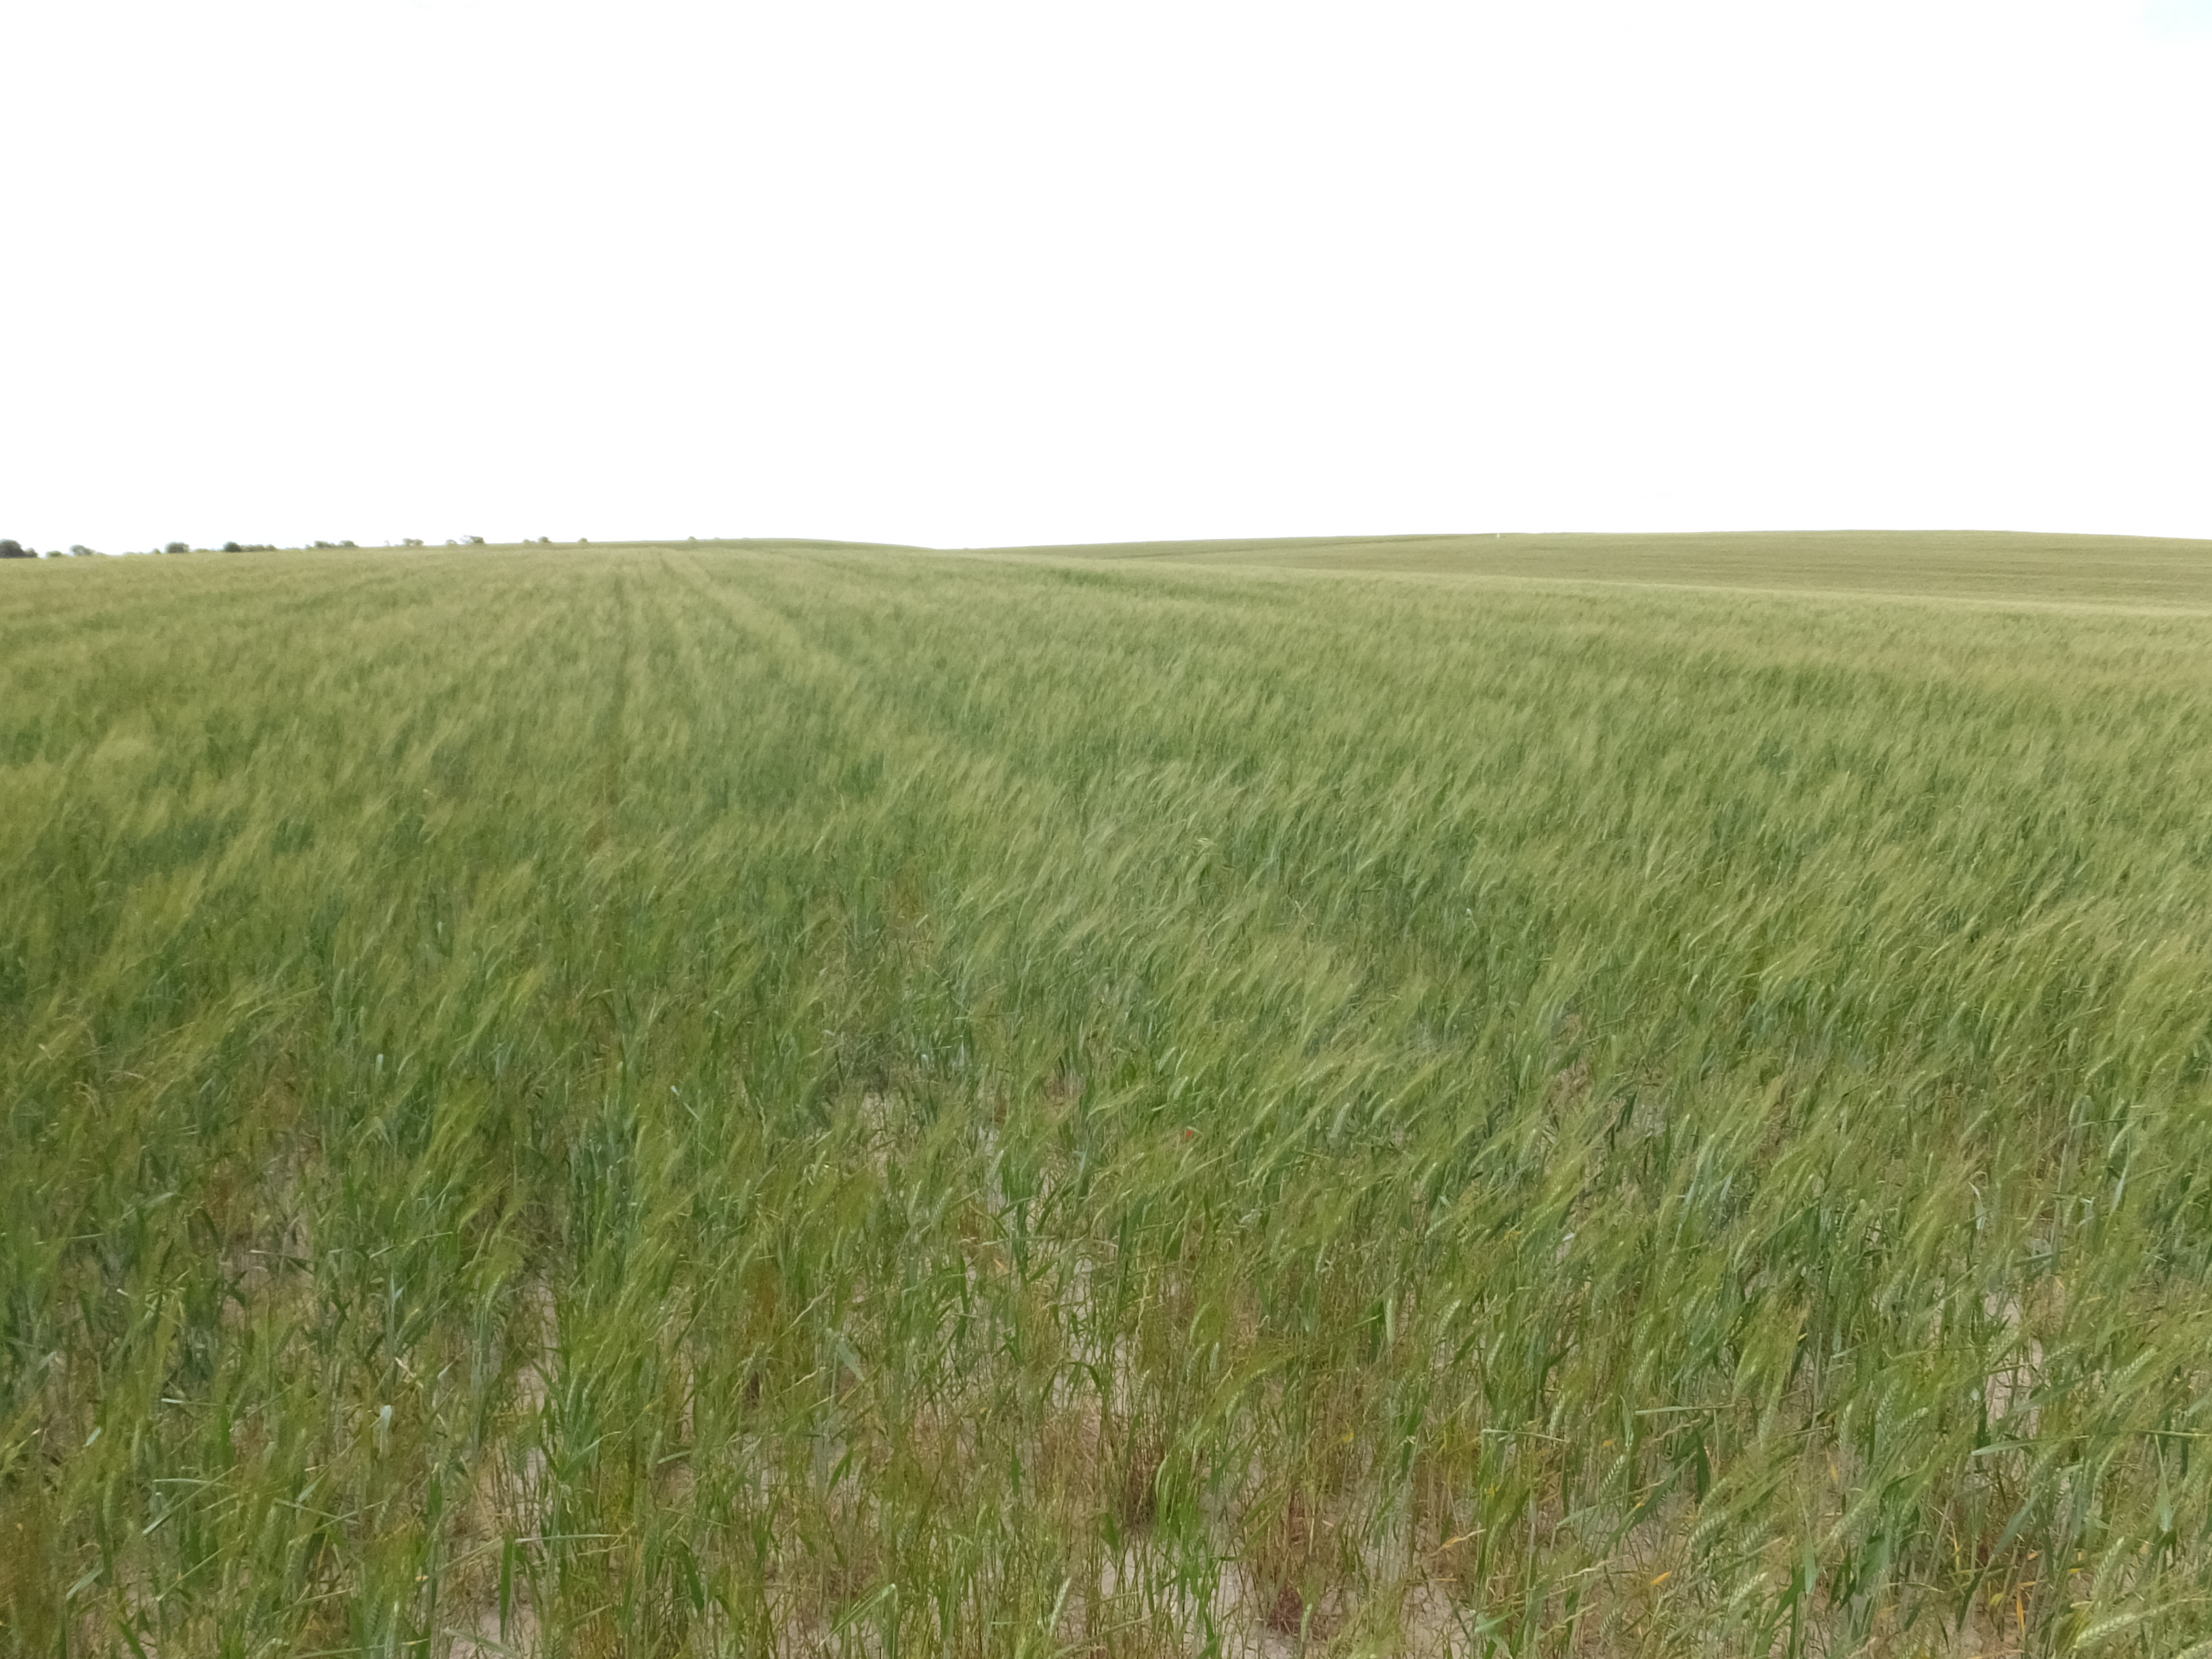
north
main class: Cropland
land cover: Durum wheat
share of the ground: > 75 %
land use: Agriculture (excluding fallow land and kitchen gardens)
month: May
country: ES
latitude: 41.6528
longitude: -0.1392
